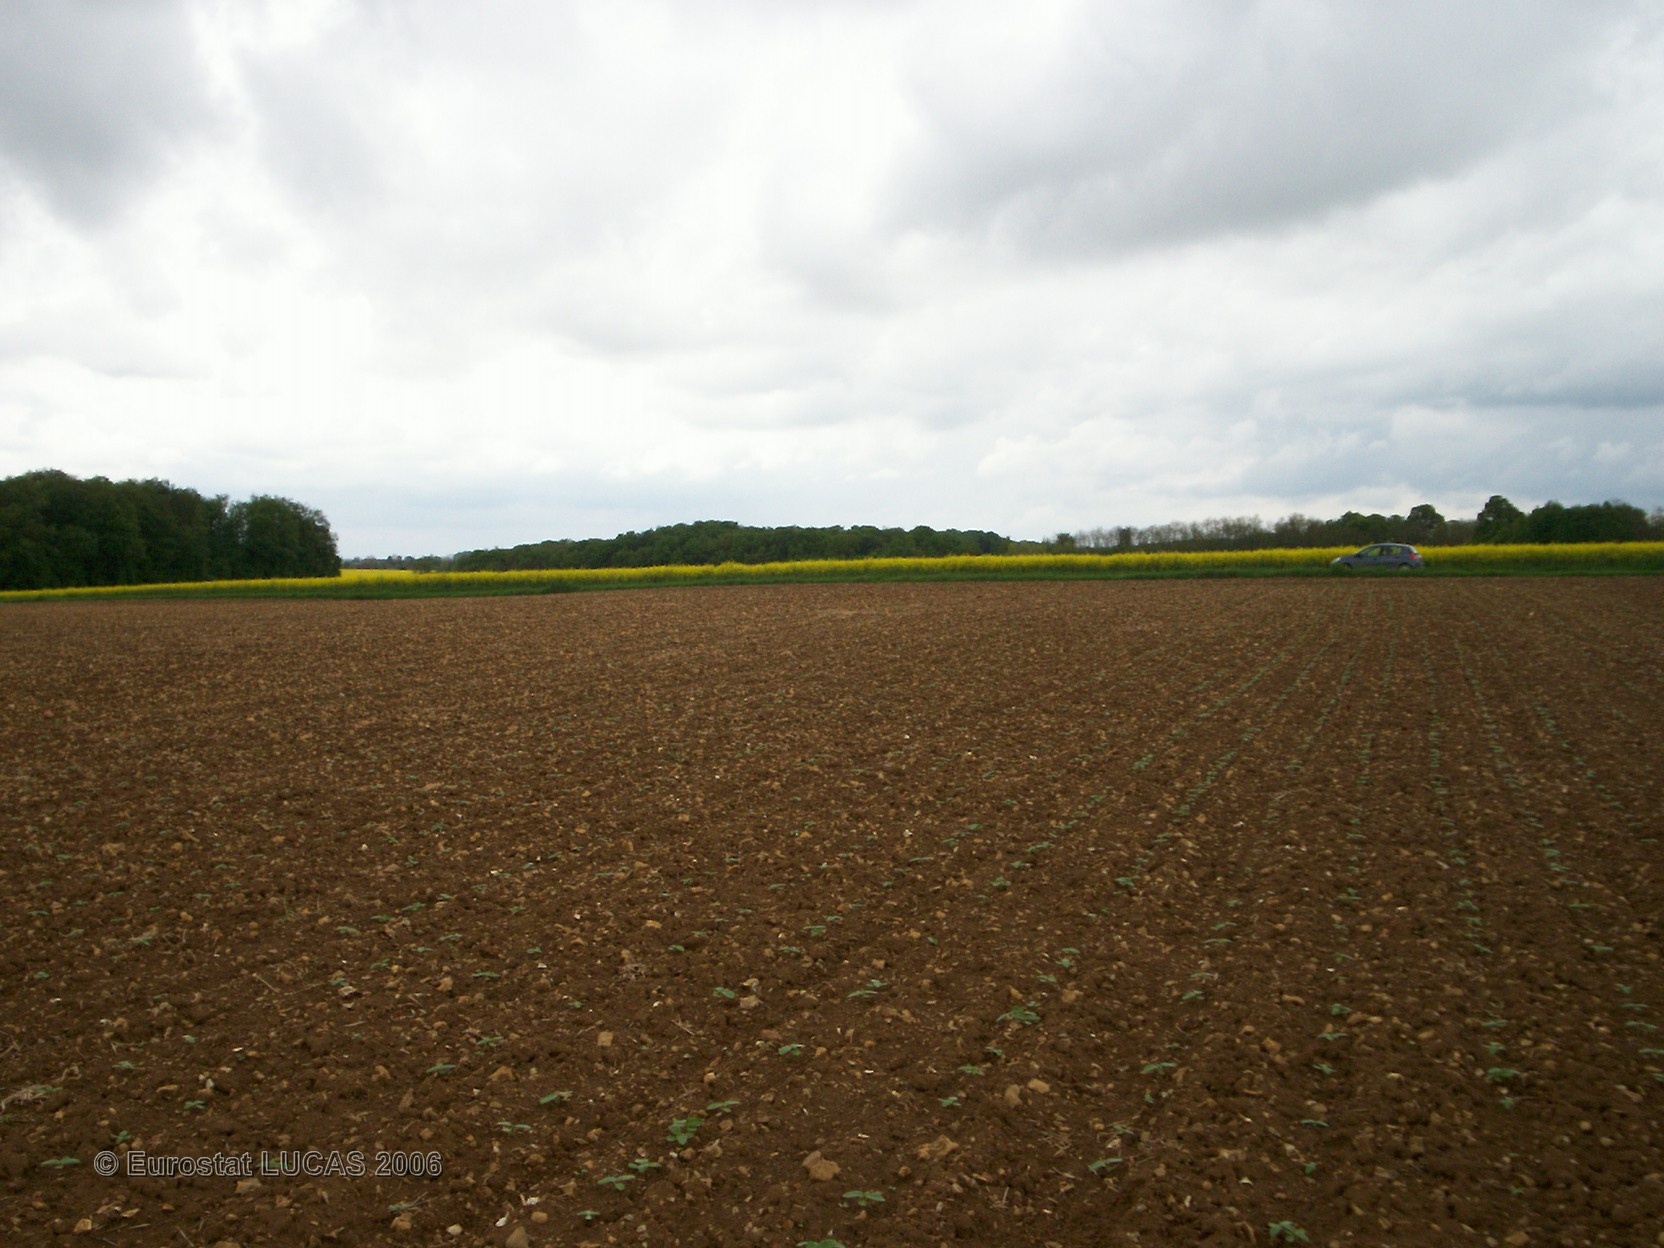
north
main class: Cropland
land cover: Sunflower
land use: Agriculture (excluding fallow land and kitchen gardens)
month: May
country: FR
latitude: 48.0178
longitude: 2.9809
